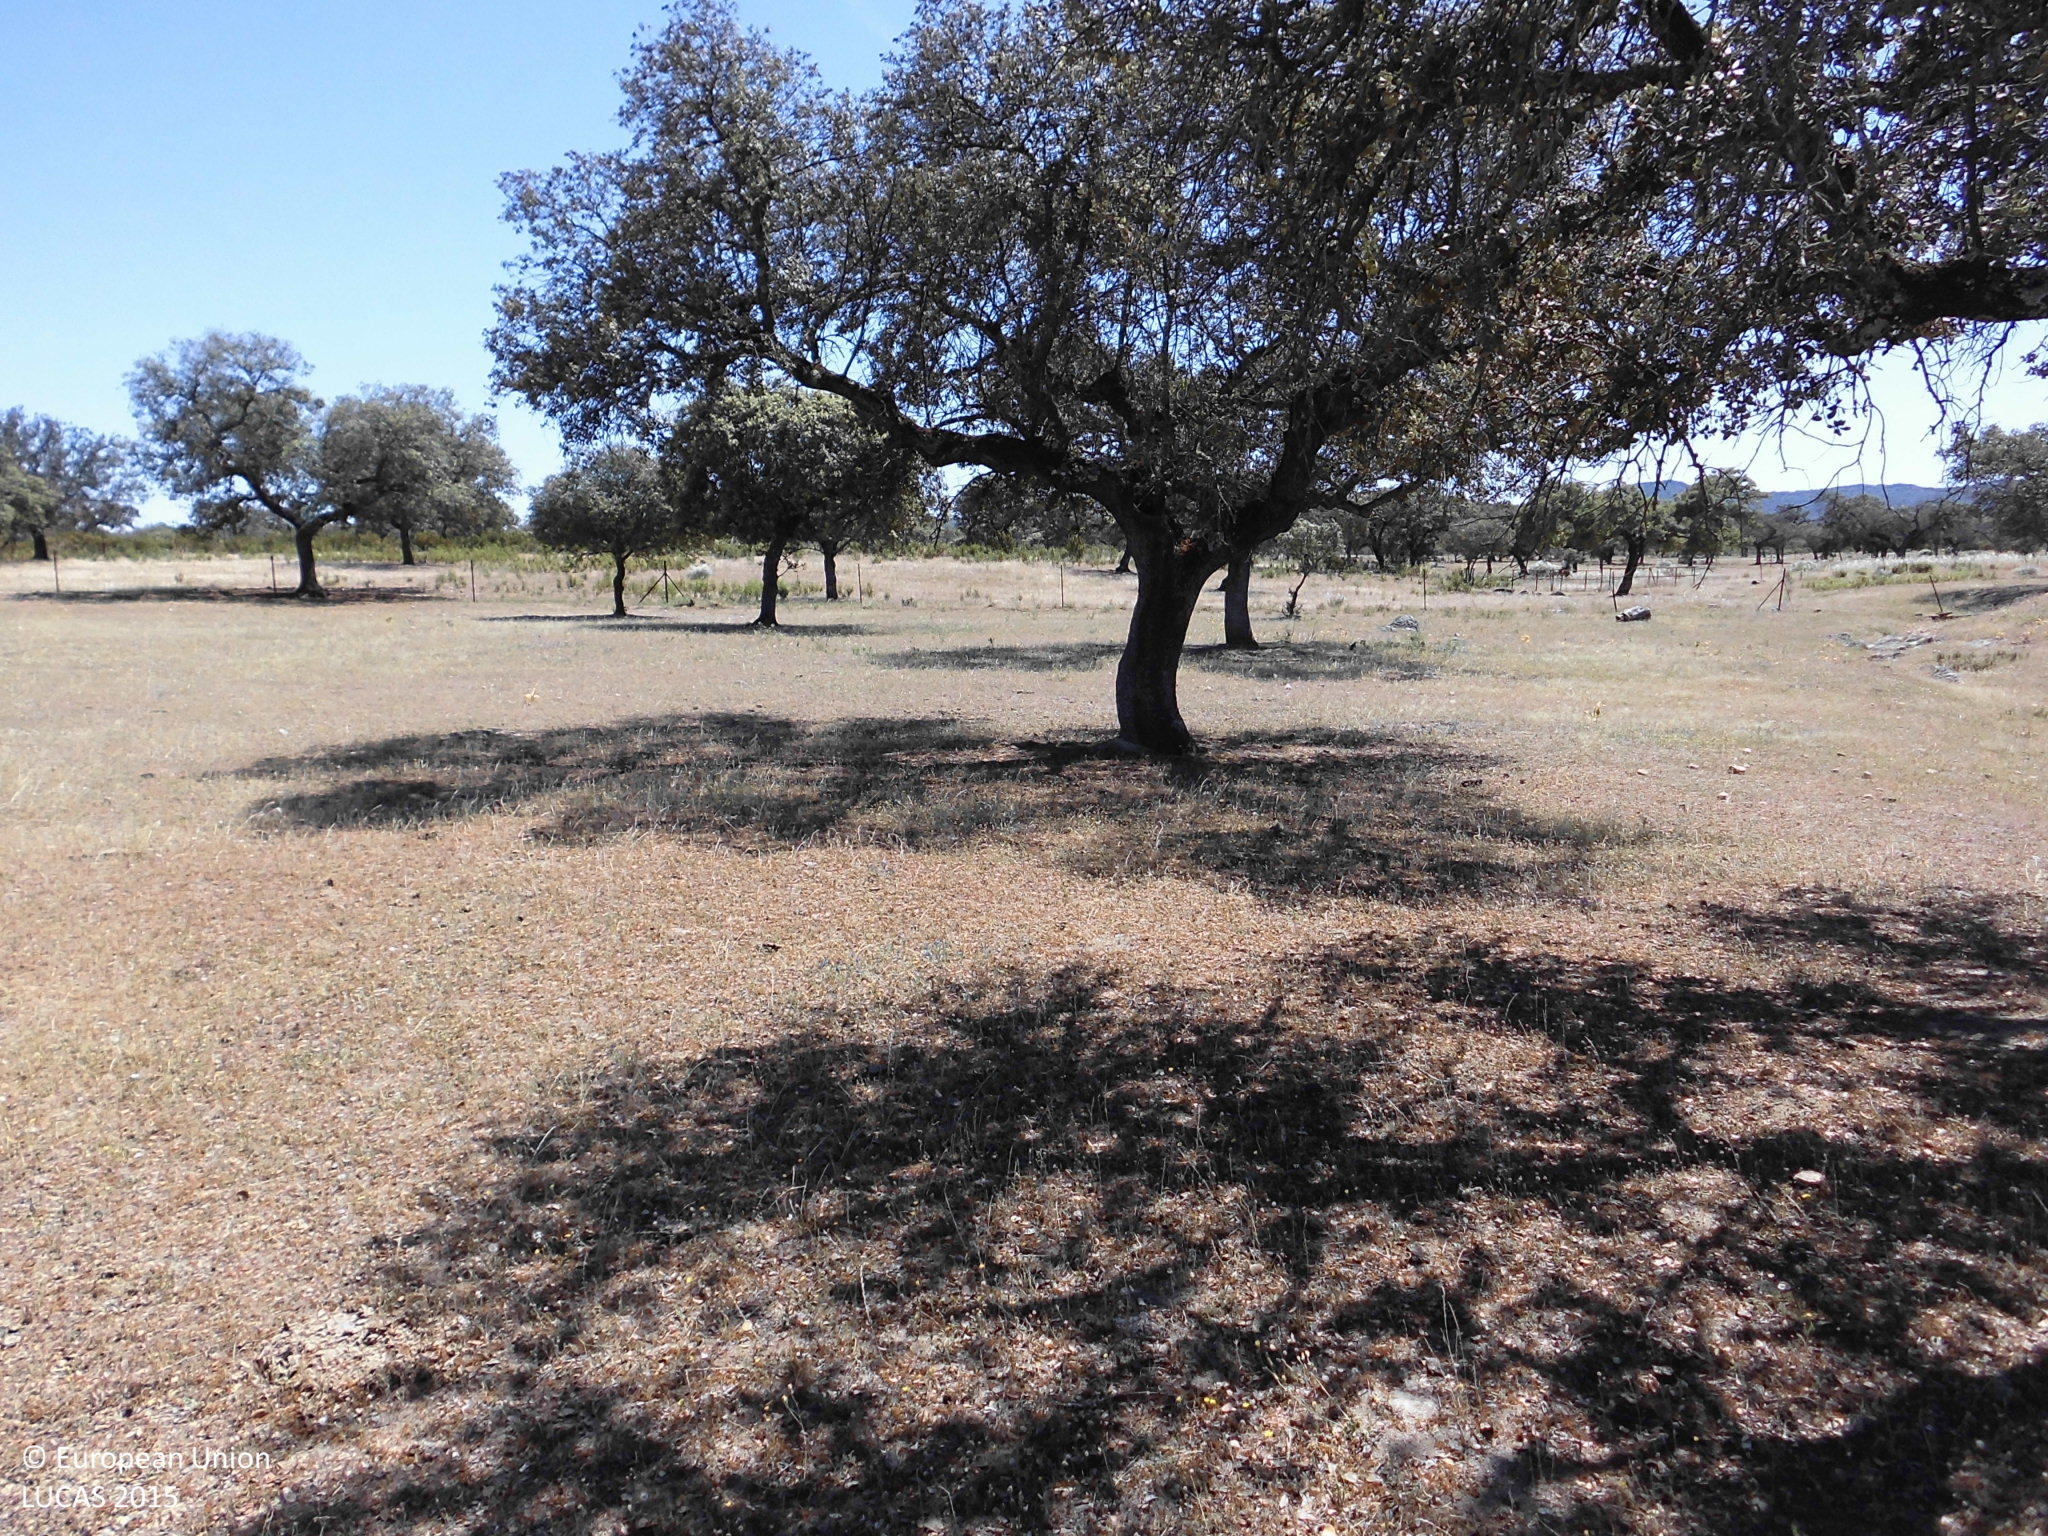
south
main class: Woodland
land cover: Broadleaved woodland
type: broadleaved evergreen forest
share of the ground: 10 - 25 %
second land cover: Grassland without tree/shrub cover
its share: > 75 %
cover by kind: herbaceous plants 80 %, broadleaved forest trees 20 %
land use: Forestry
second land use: Agriculture (excluding fallow land and kitchen gardens)
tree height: > 5 m
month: May
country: ES
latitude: 39.4500
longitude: -6.9173
